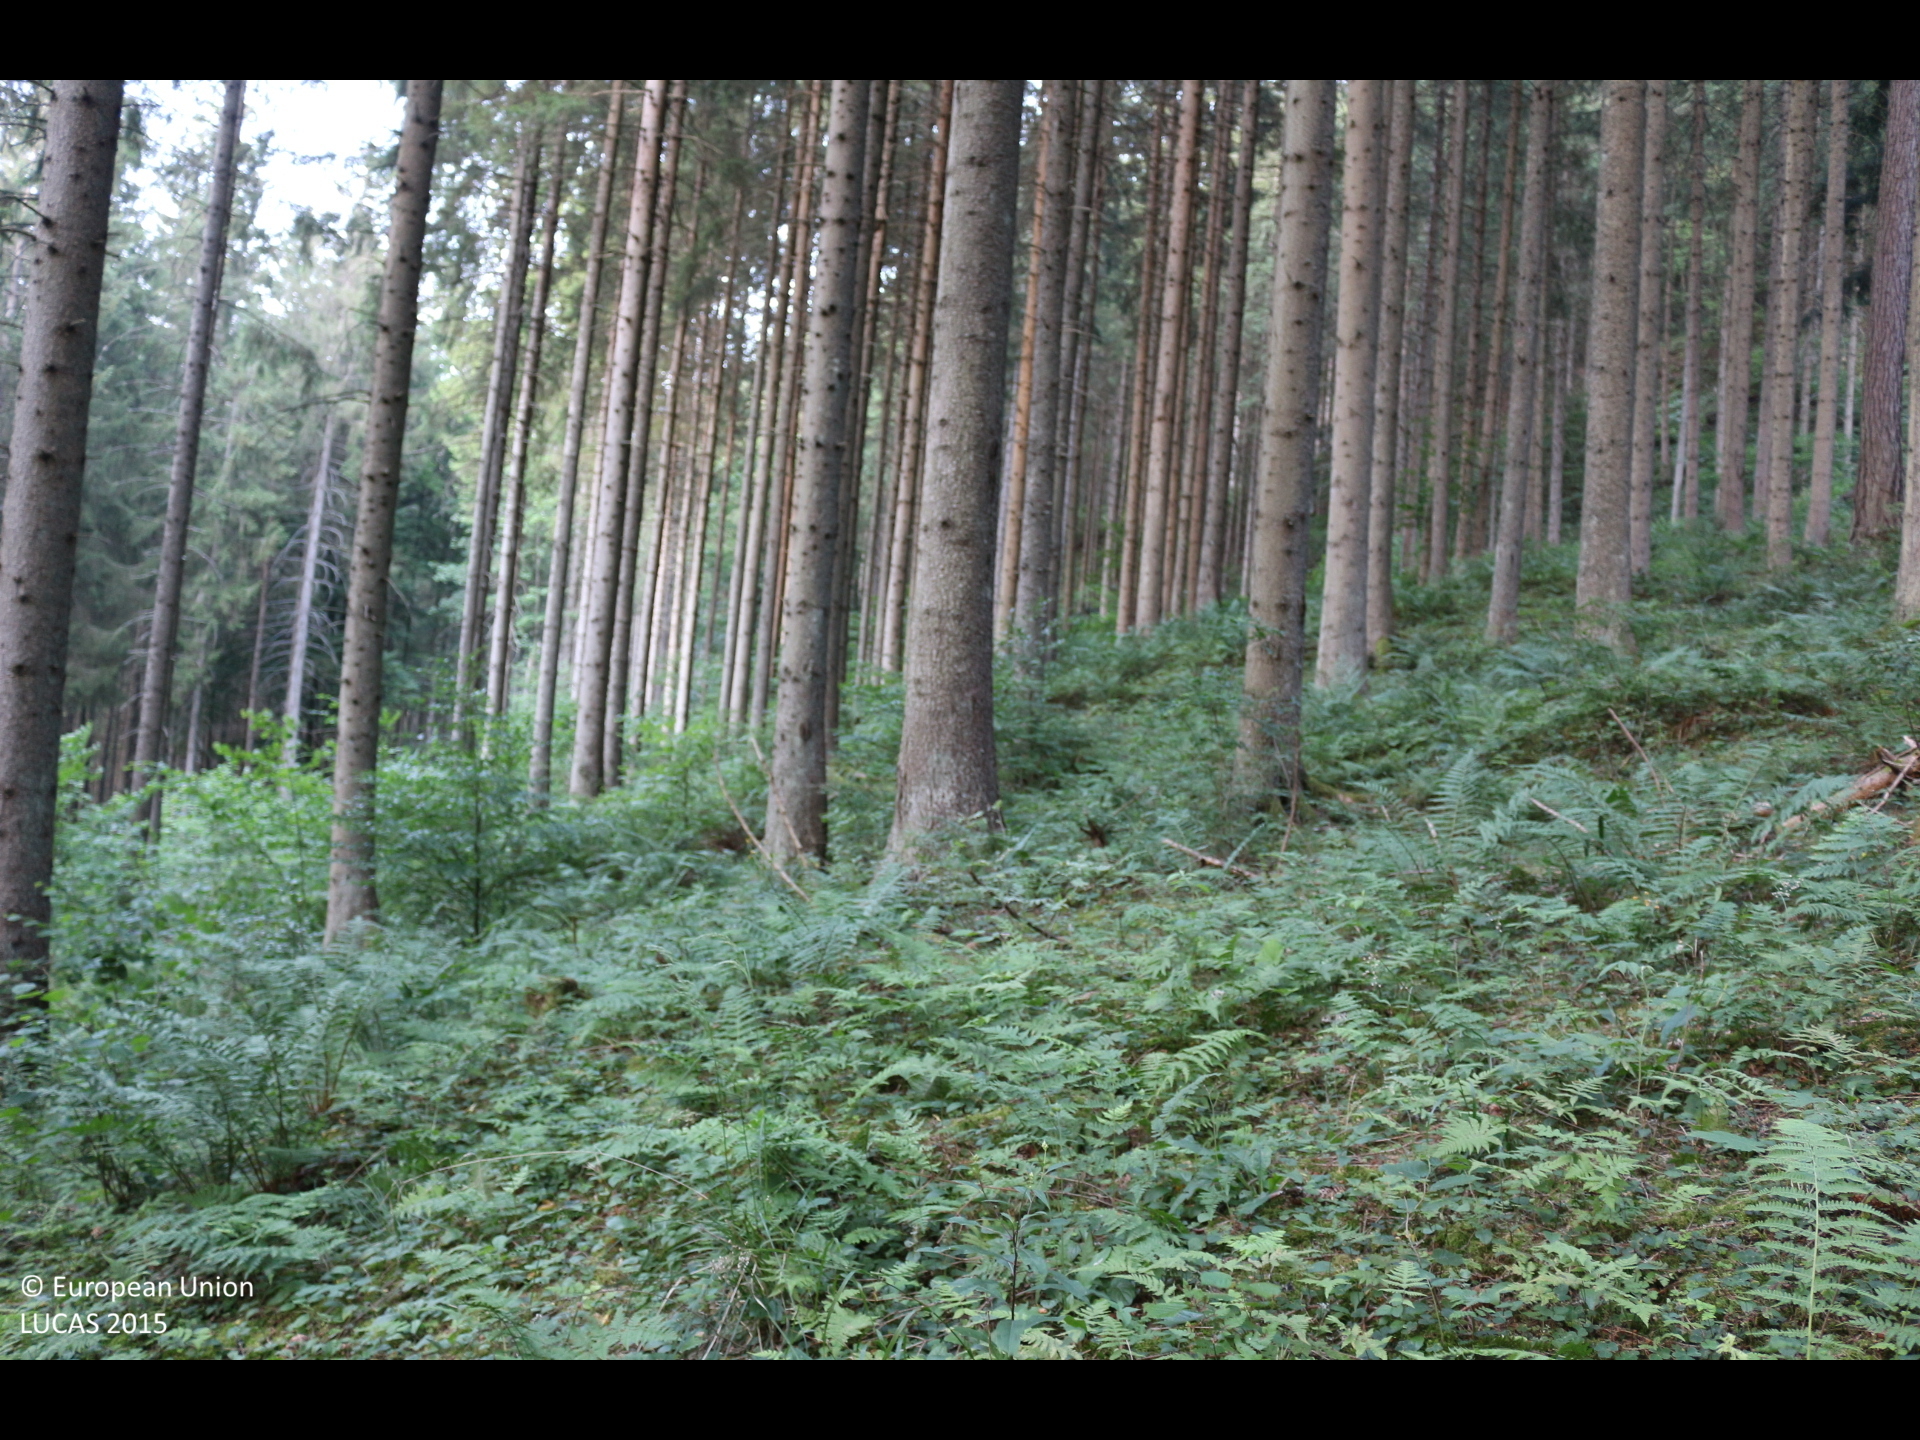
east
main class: Woodland
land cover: Spruce dominated coniferous woodland
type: alpine coniferous forest
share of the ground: > 75 %
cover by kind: coniferous forest trees 100 %
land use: Forestry
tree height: > 5 m
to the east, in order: Spruce dominated coniferous woodland; Tracks; Spruce dominated coniferous woodland; Spruce dominated mixed woodland; Spruce dominated coniferous woodland; Spruce dominated mixed woodland; Rocks and stones; Spruce dominated mixed woodland
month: July
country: AT
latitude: 46.7936
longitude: 14.1506
